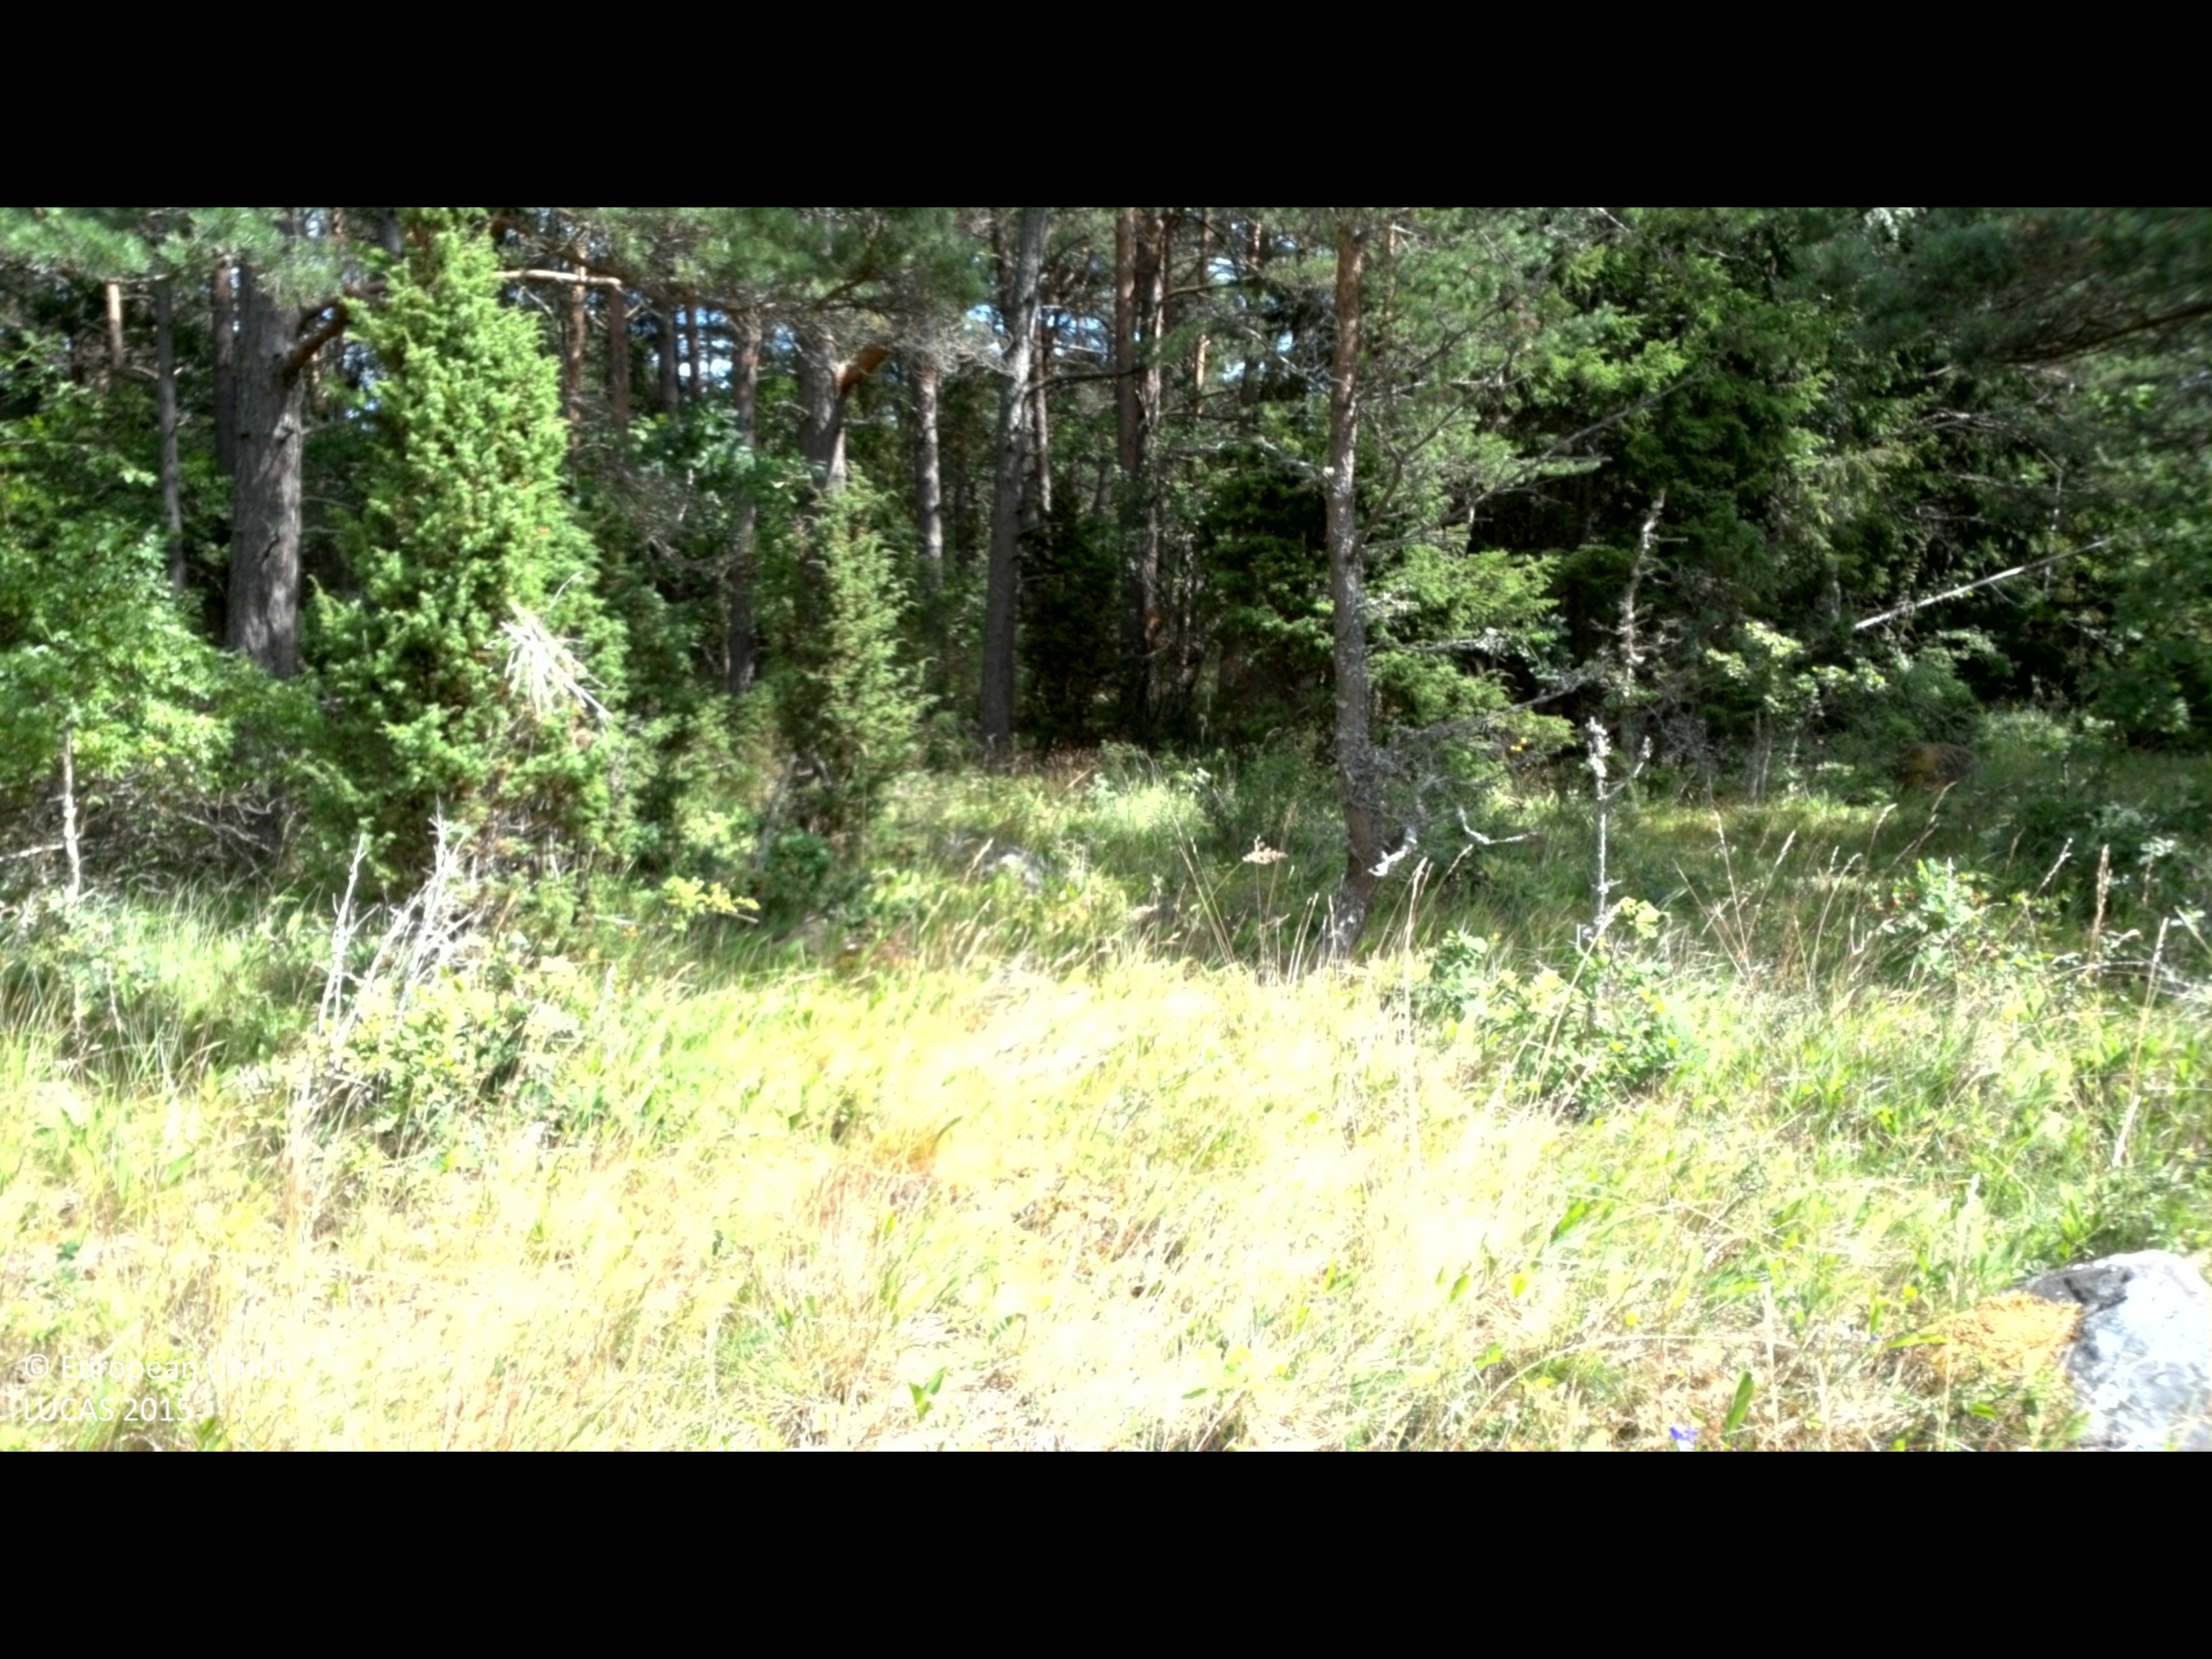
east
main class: Shrubland
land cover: Shrubland with sparse tree cover
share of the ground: 10 - 25 %
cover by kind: herbaceous plants 75 %, shrubs 20 %, coniferous forest trees 5 %
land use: Amenities, museums, leisure
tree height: < 5 m
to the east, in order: Shrubland with sparse tree cover; Pine dominated coniferous woodland; Broadleaved woodland; Pine dominated coniferous woodland; Shrubland with sparse tree cover
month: July
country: SE
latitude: 57.3473
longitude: 17.0642
